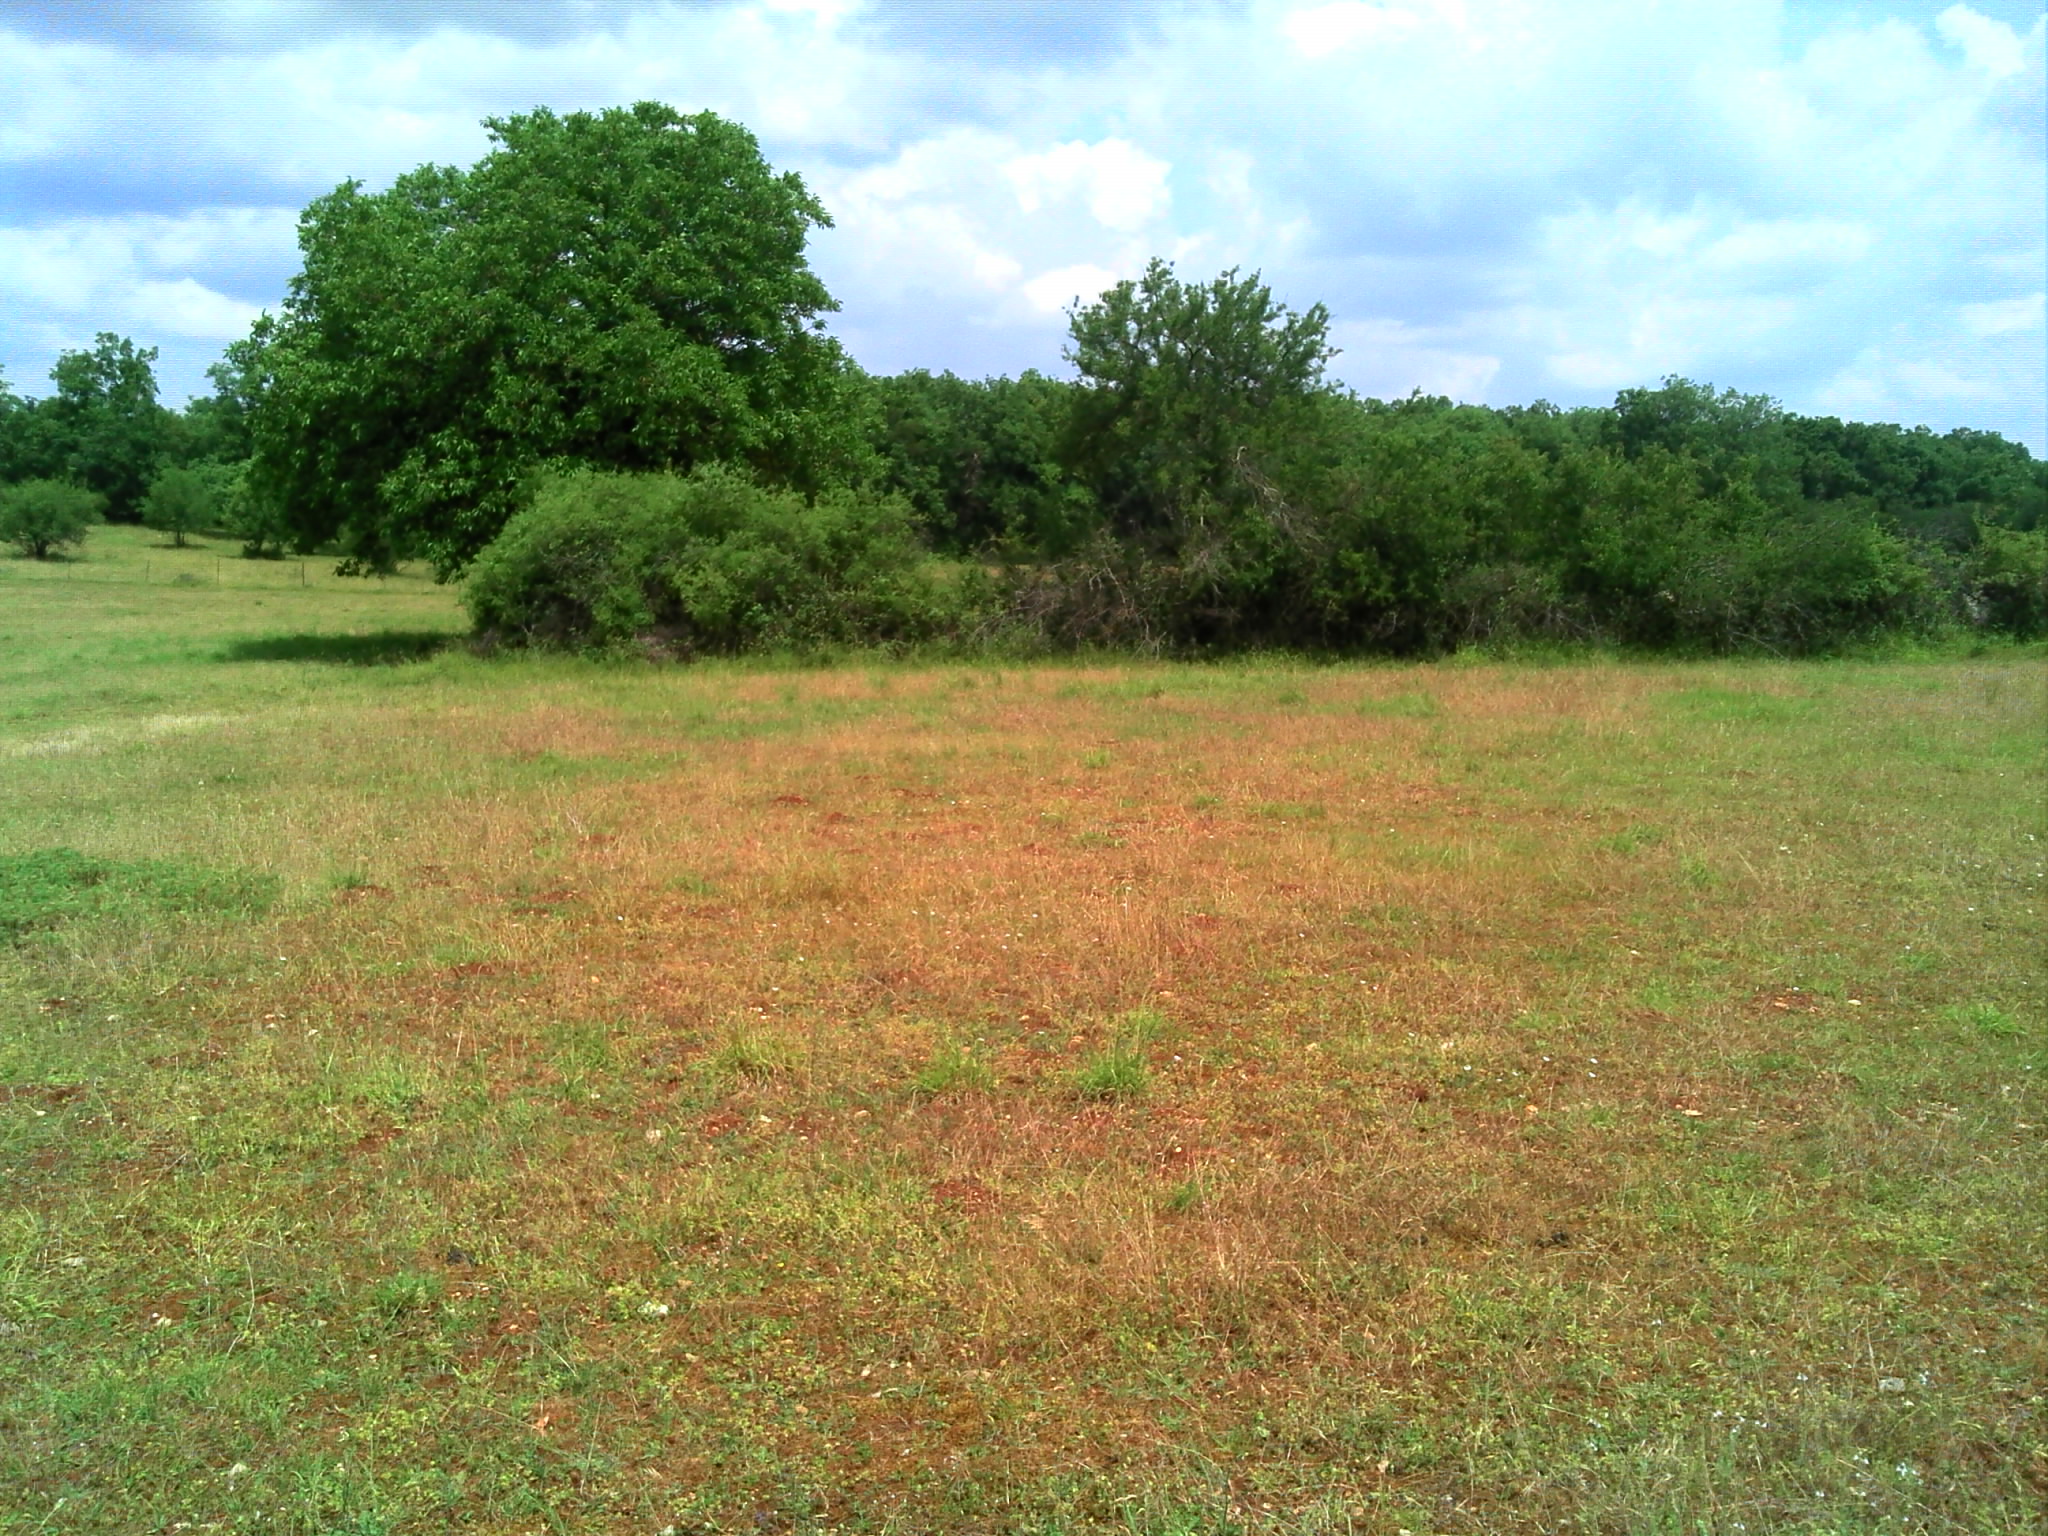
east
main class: Grassland
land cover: Spontaneously vegetated surfaces
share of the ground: > 75 %
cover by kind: herbaceous plants 95 %, shrubs 5 %
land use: Agriculture (excluding fallow land and kitchen gardens)
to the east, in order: Spontaneously vegetated surfaces; Managed hedges; Dry stone walls; Grass margins; Paved roads, cycling and walking lanes; Grass margins; Single bushes/trees; Managed hedges; Grassland without tree/shrub cover
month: June
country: FR
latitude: 44.6052
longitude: 1.7968
